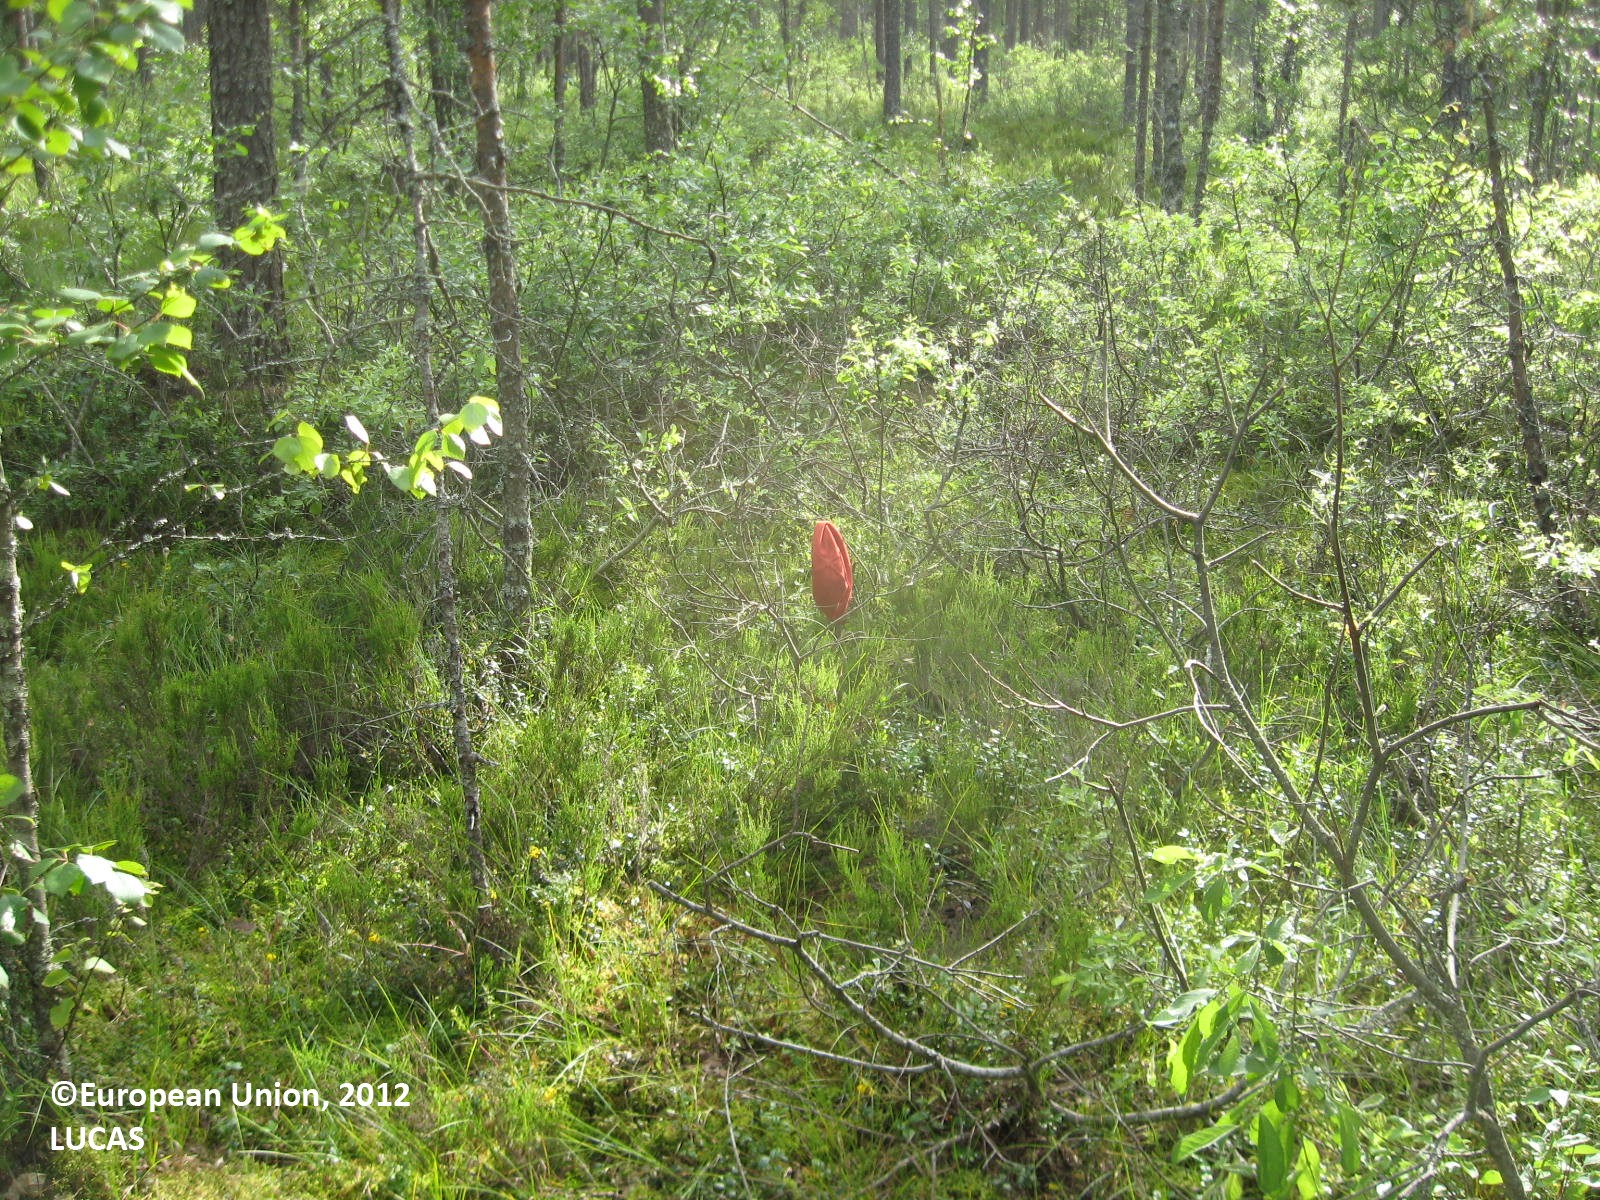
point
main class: Woodland
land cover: Pine dominated mixed woodland
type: boreal forest
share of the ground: > 75 %
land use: Forestry
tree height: > 5 m
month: July
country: FI
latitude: 62.1495
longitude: 22.4338
